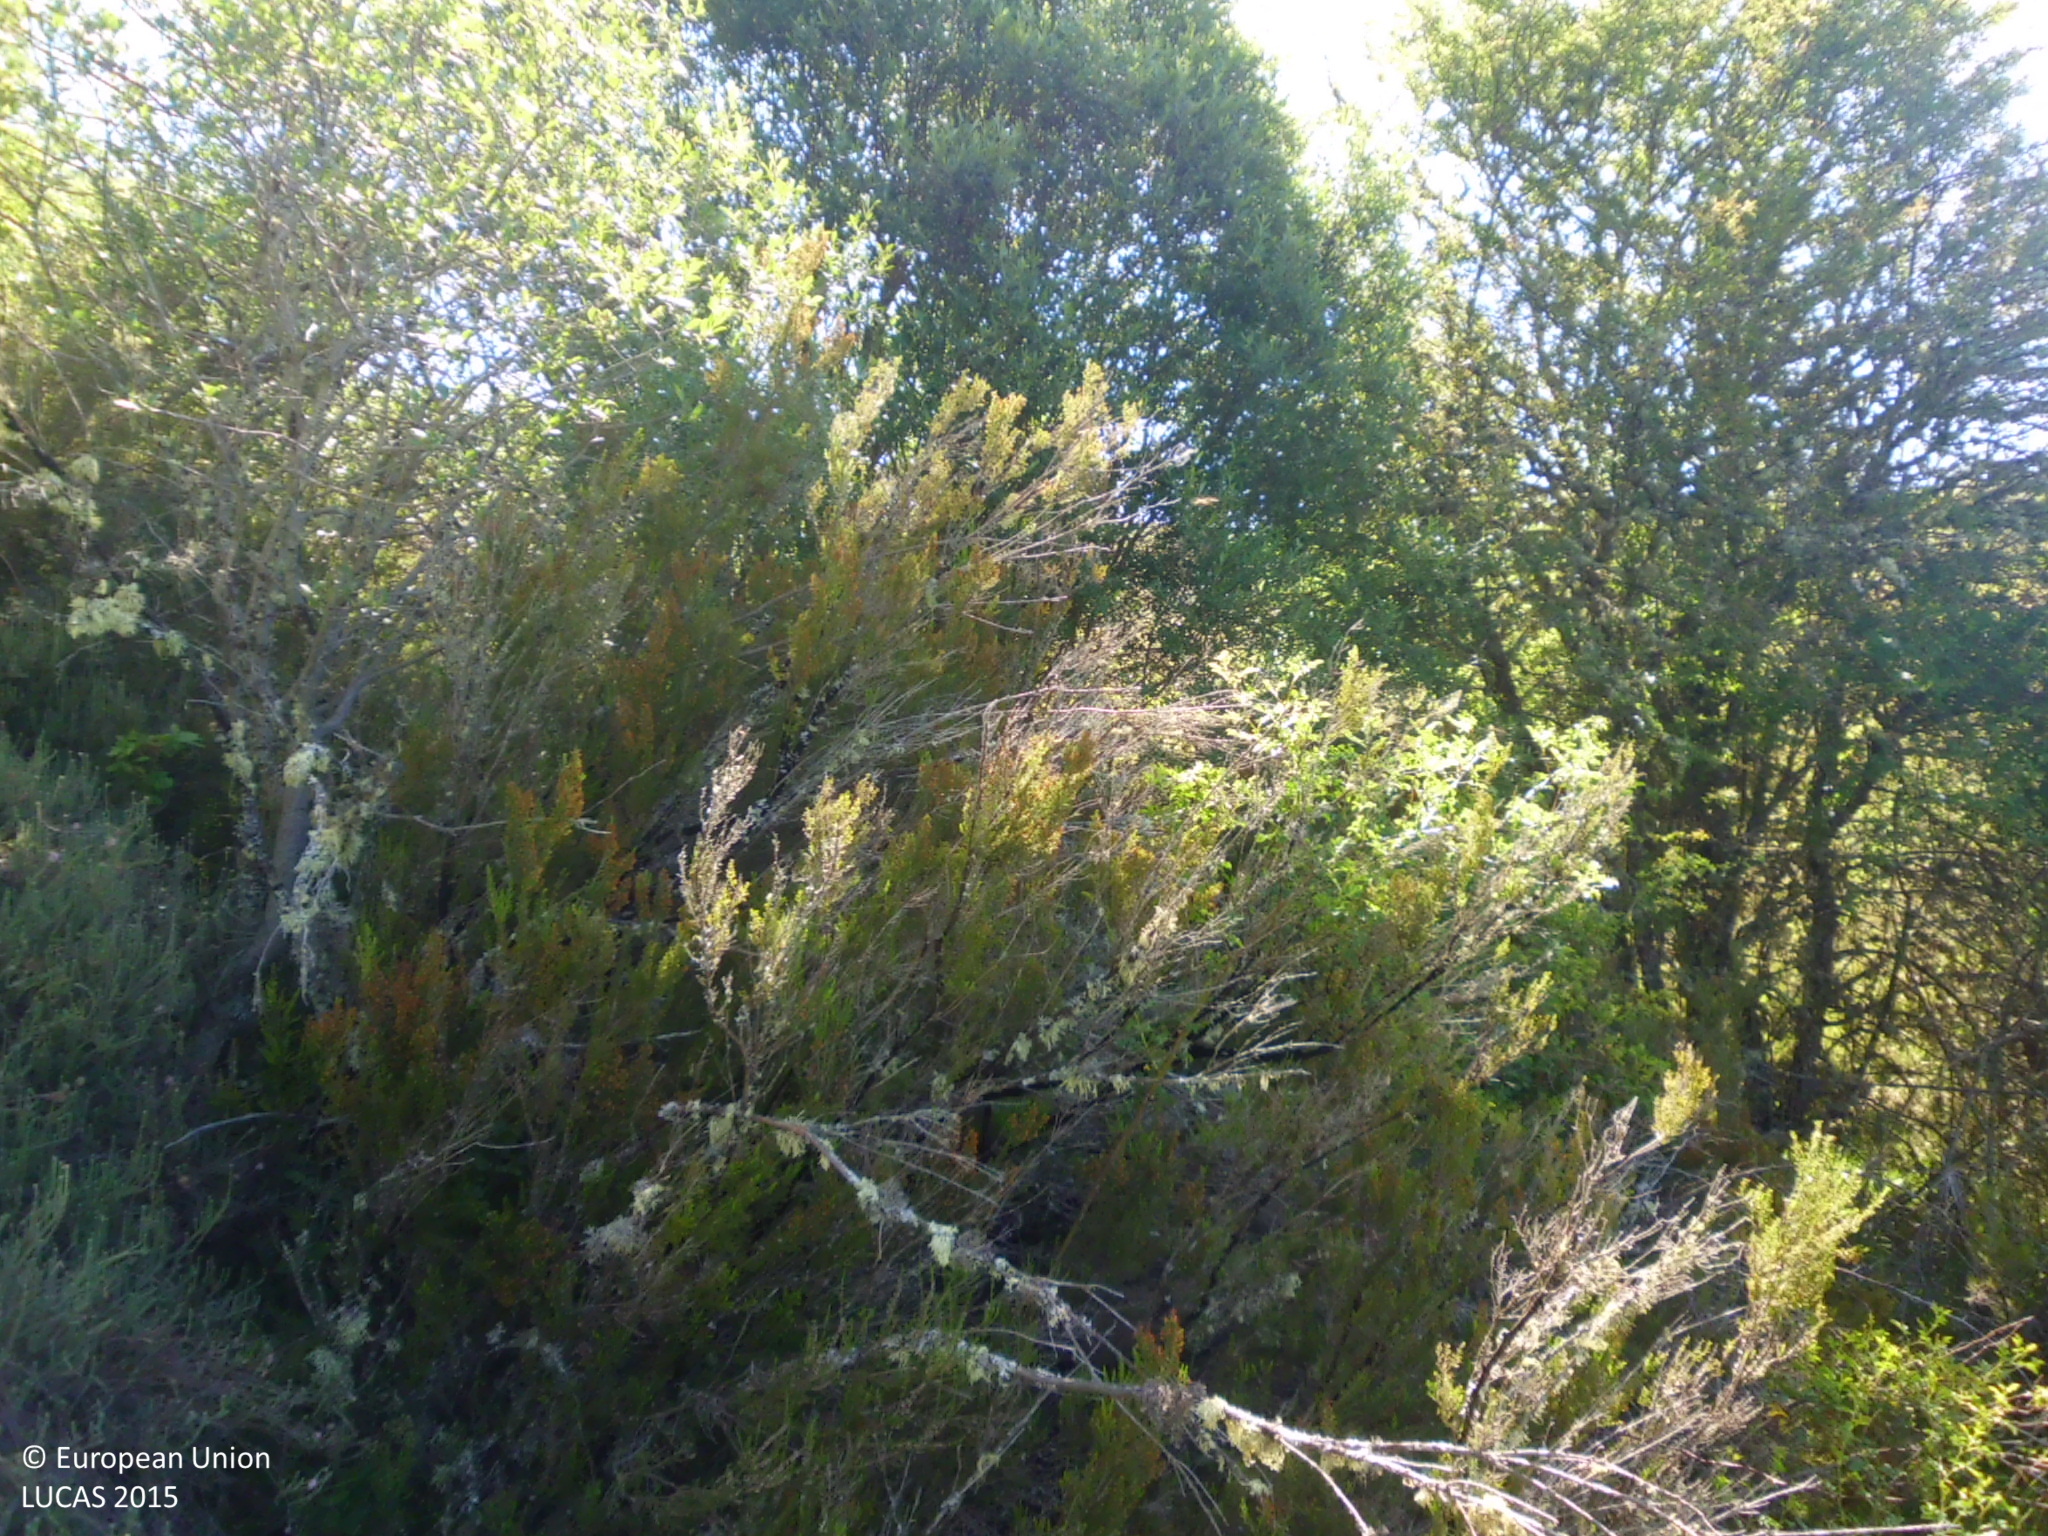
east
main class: Shrubland
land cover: Shrubland with sparse tree cover
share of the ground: 25 - 50 %
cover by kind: herbaceous plants 55 %, shrubs 40 %, broadleaved forest trees 5 %
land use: Semi-natural and natural areas not in use
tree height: < 5 m
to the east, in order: Shrubland with sparse tree cover; Rivers and streams; Shrubland with sparse tree cover
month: June
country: ES
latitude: 42.7289
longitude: -4.9497
